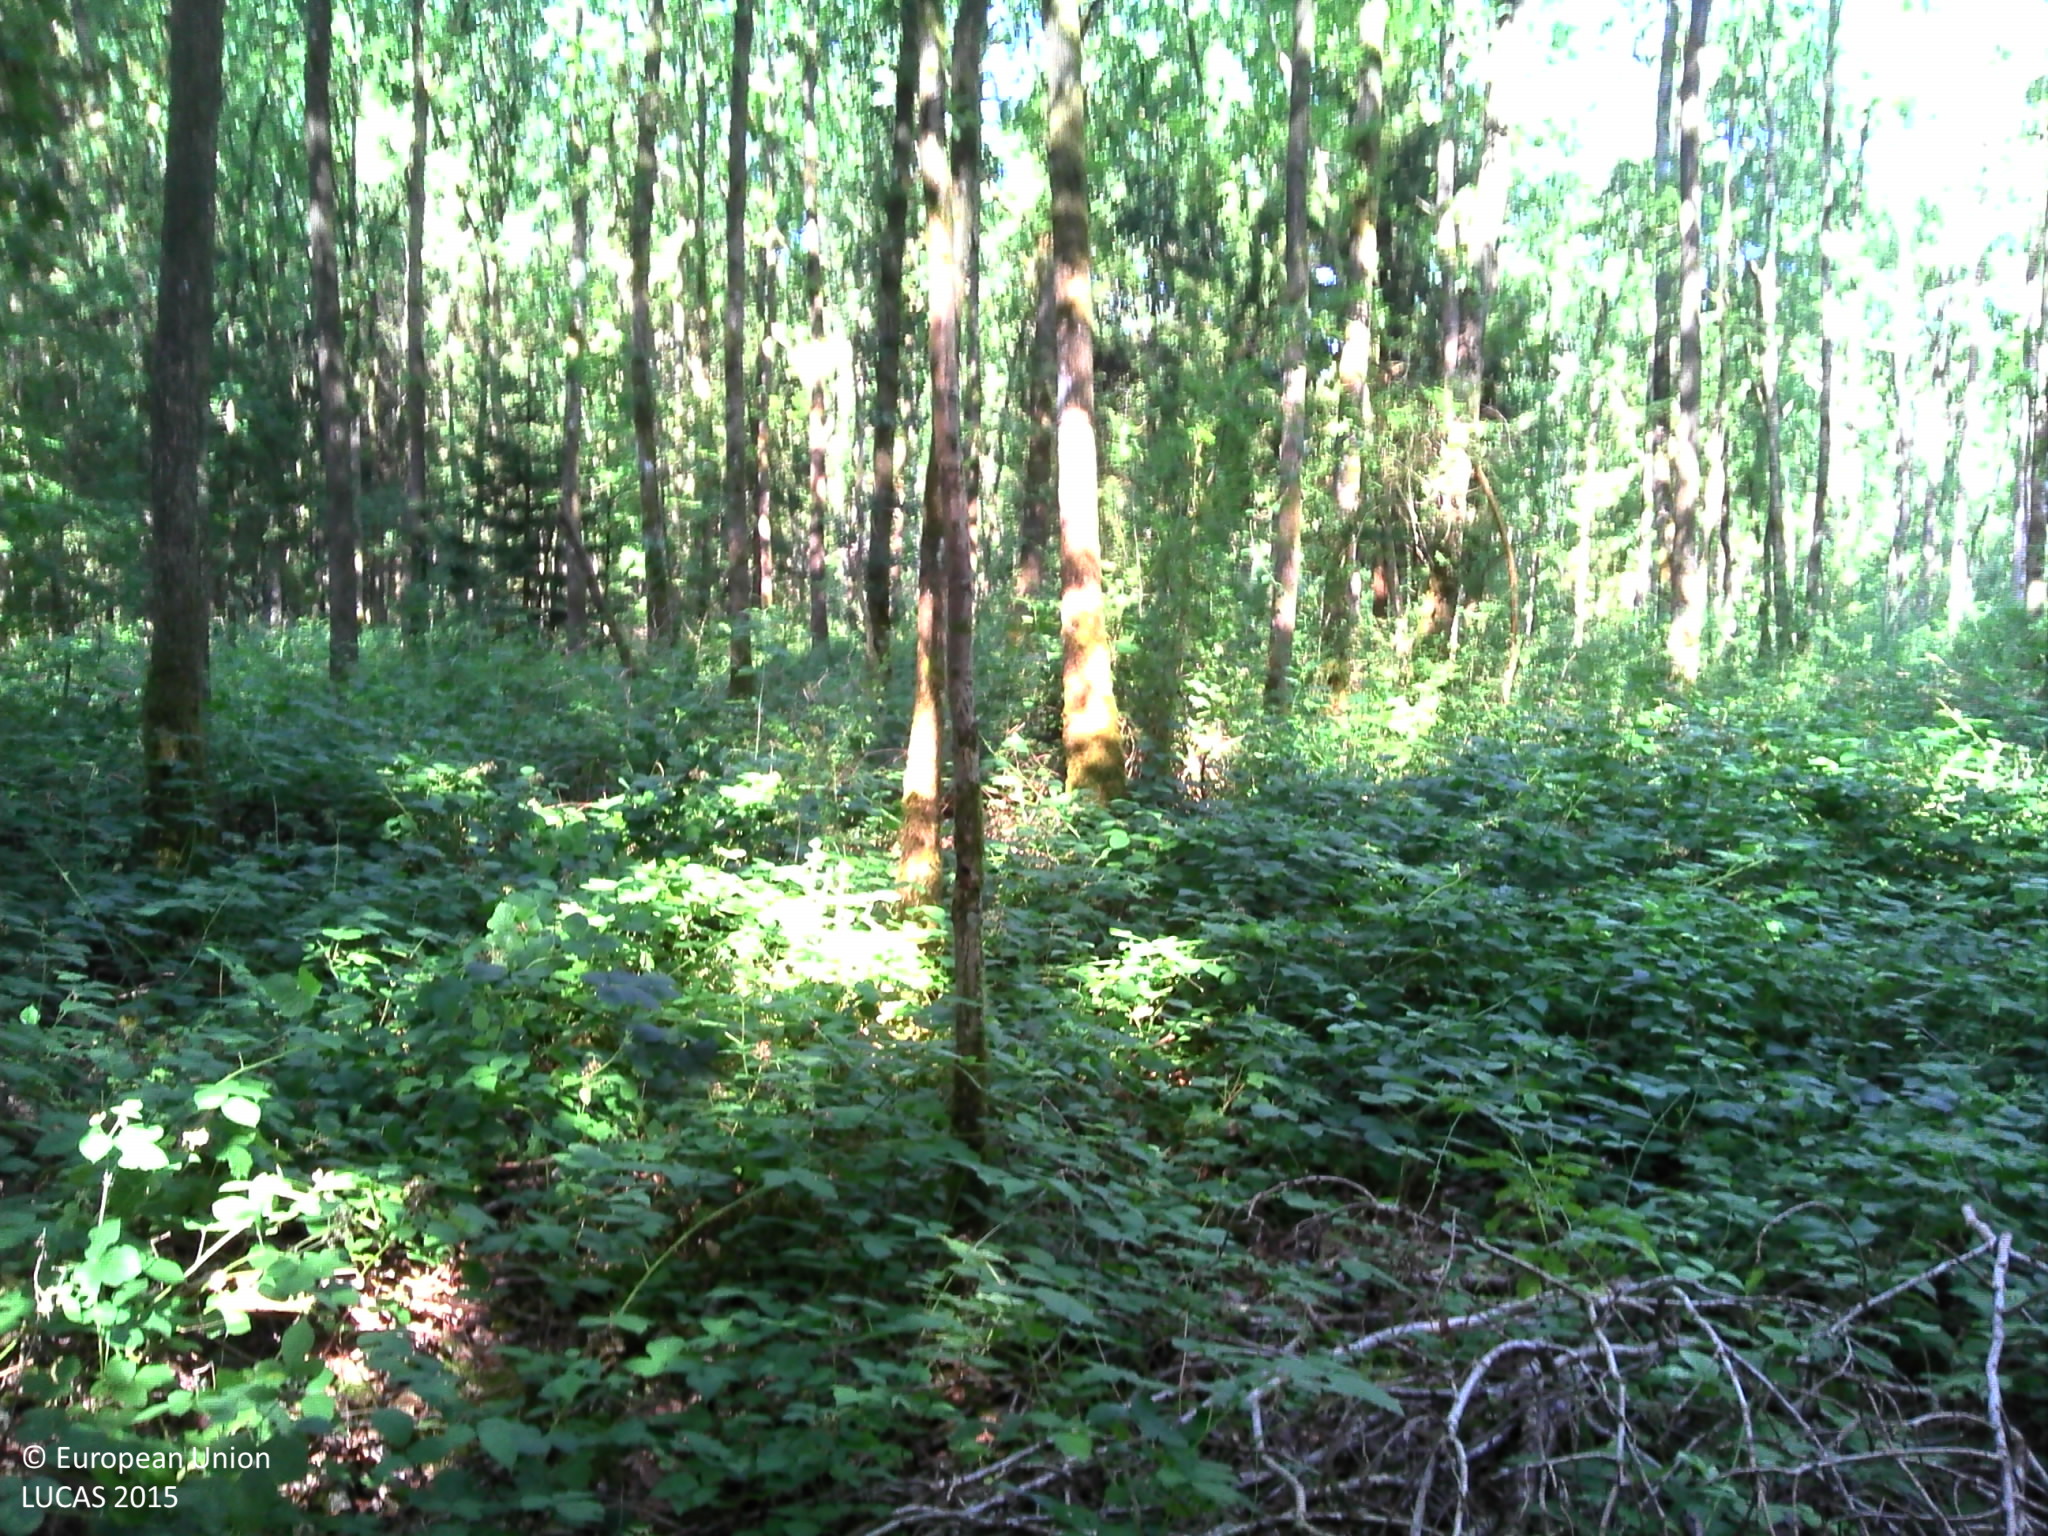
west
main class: Woodland
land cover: Broadleaved woodland
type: acidophilous oak and oak-birch forest
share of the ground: > 75 %
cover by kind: broadleaved forest trees 90 %, coniferous forest trees 10 %
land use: Forestry
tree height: > 5 m
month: July
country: BE
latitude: 49.6831
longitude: 5.5495
